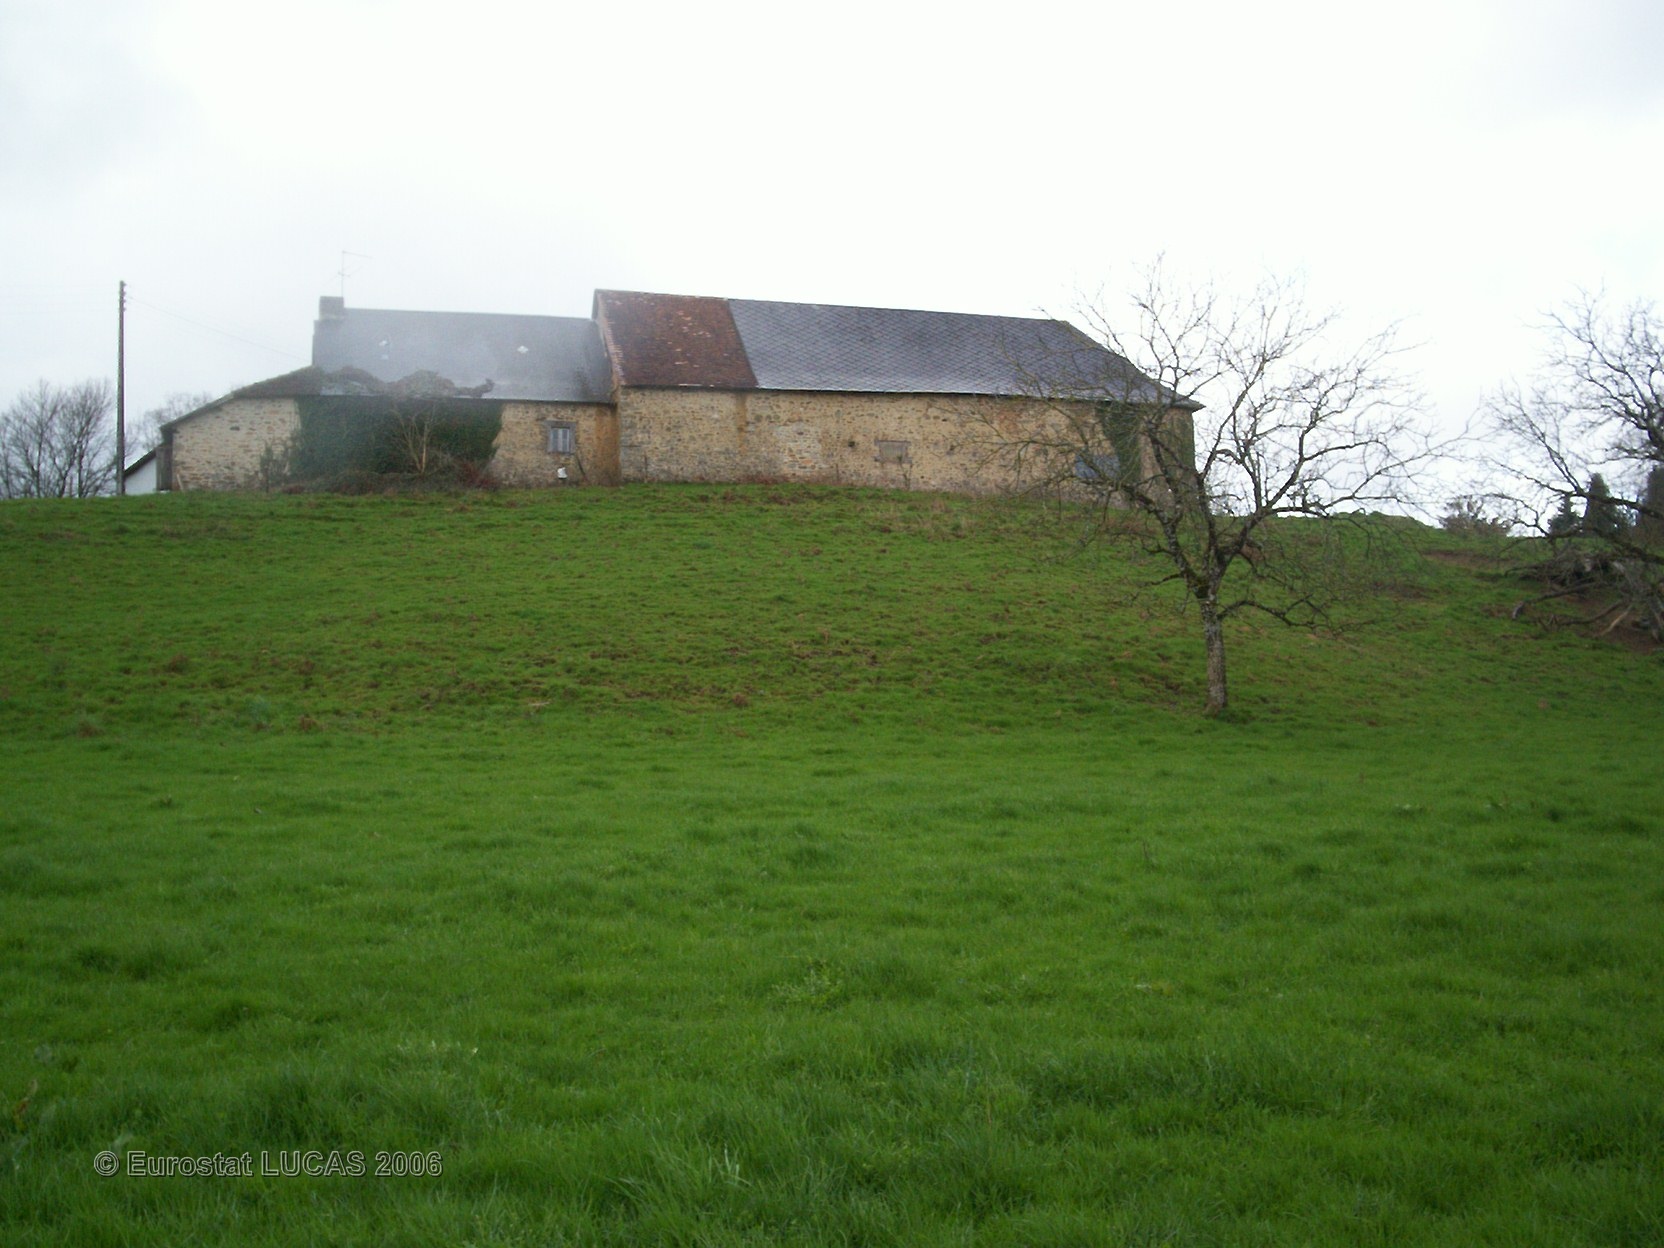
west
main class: Grassland
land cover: Grassland with sparse tree/shrub cover
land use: Agriculture (excluding fallow land and kitchen gardens)
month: April
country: FR
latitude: 45.5678
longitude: 1.6014
